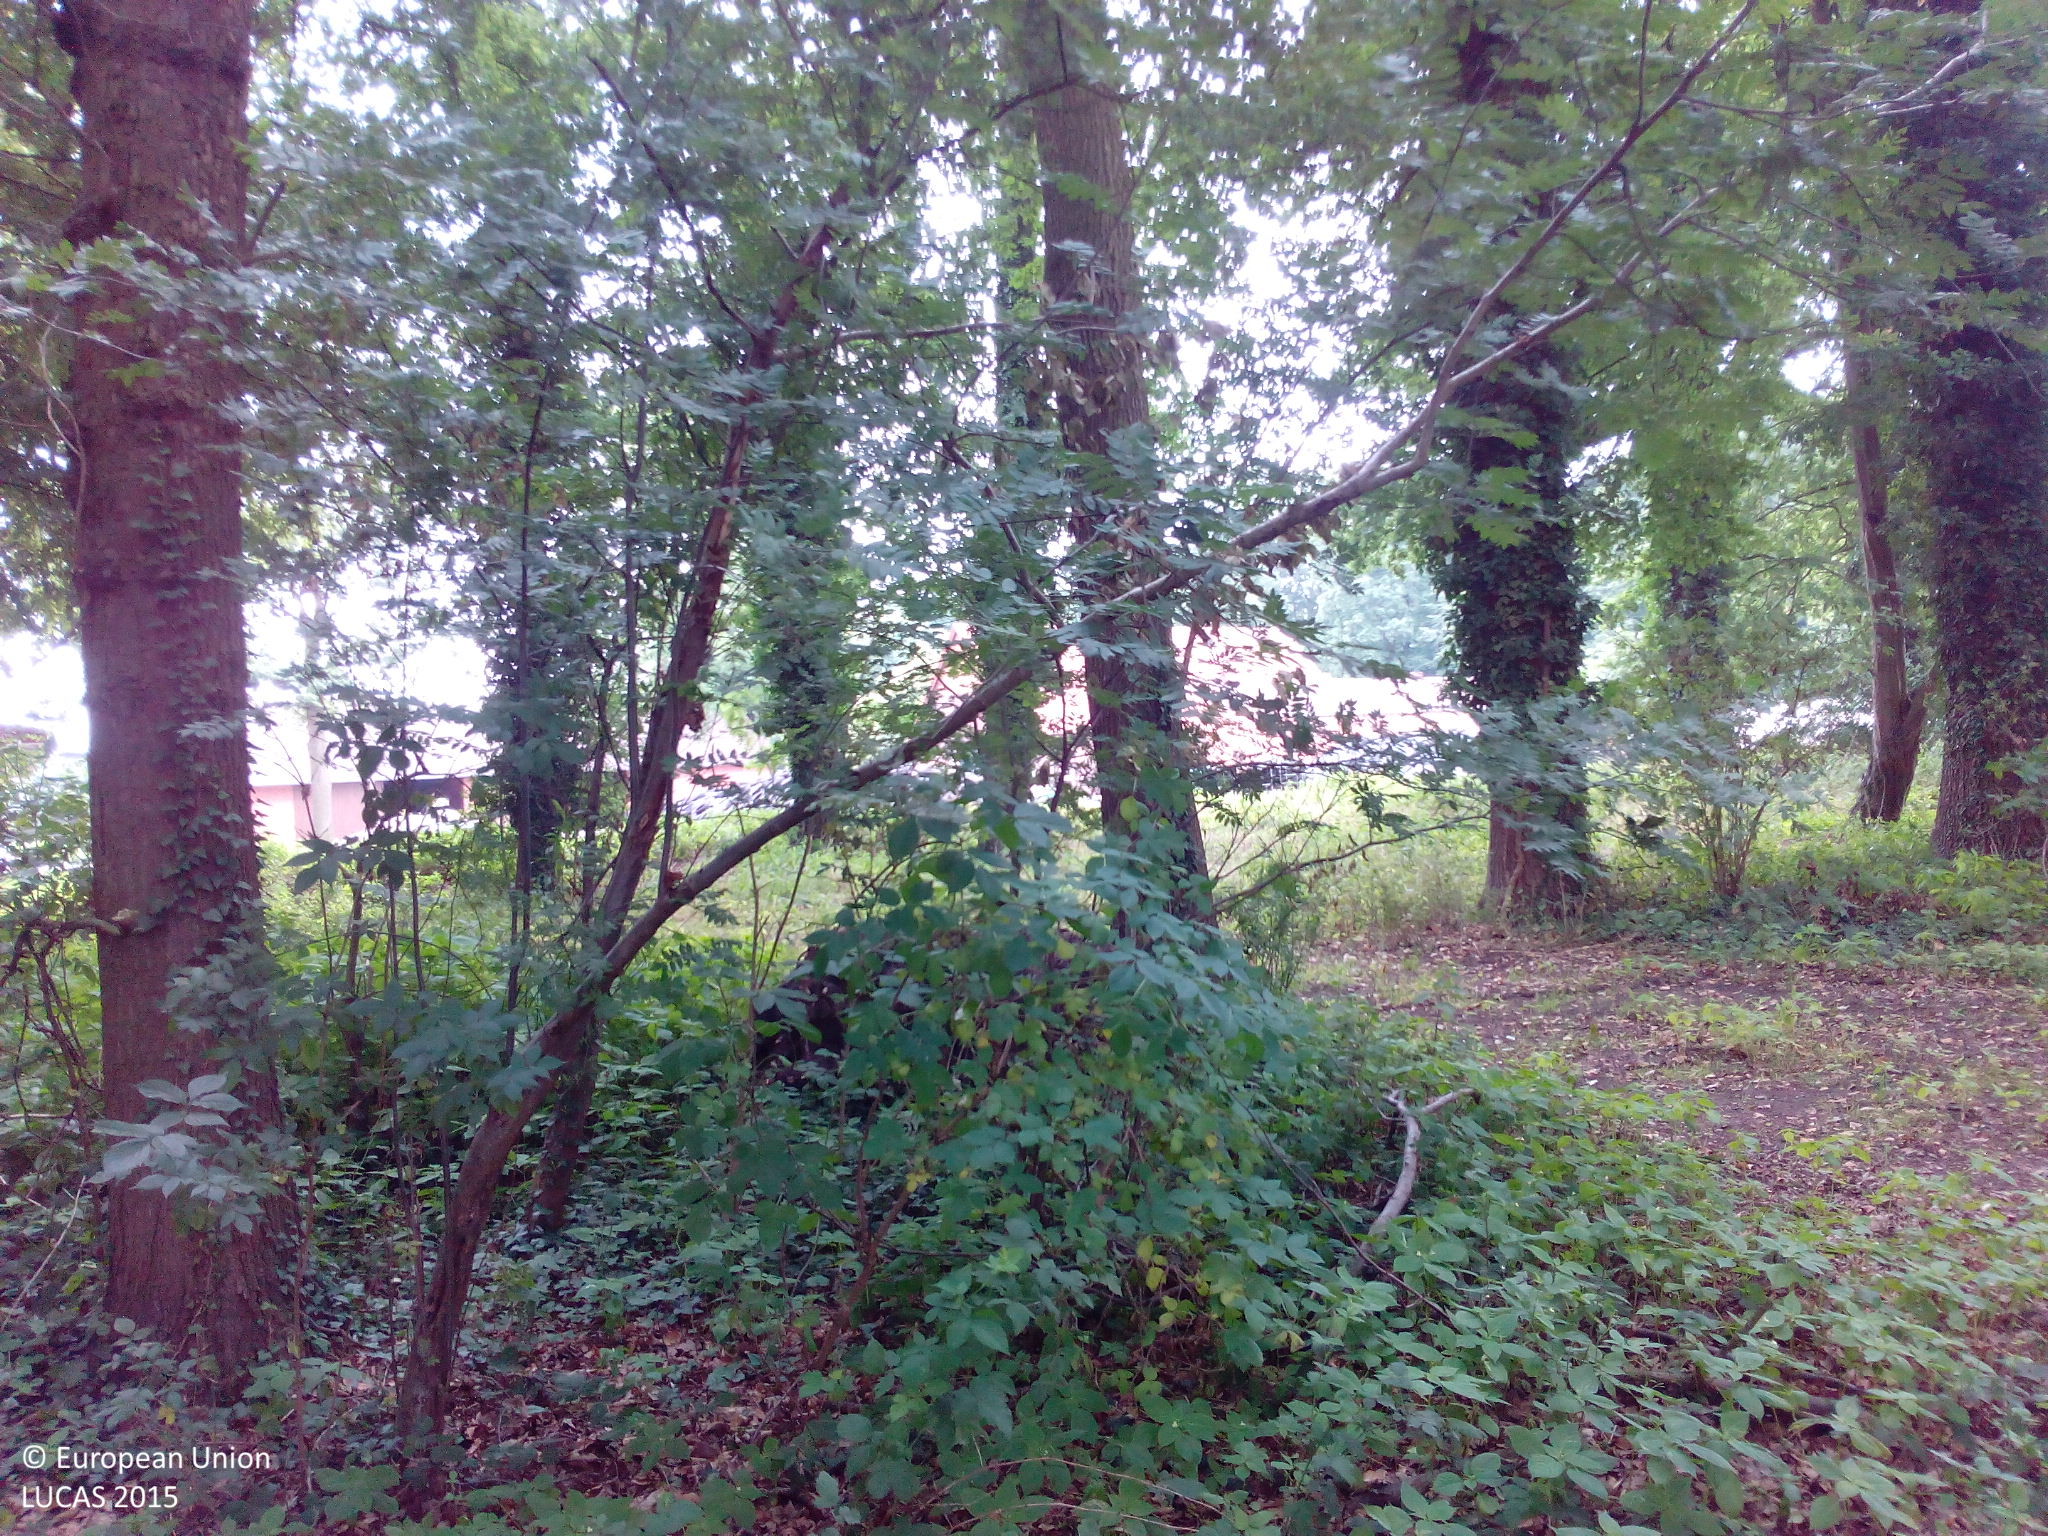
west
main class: Woodland
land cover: Broadleaved woodland
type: mesophytic deciduous forest
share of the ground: > 75 %
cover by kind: broadleaved forest trees 100 %
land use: Agriculture (excluding fallow land and kitchen gardens)
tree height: > 5 m
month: July
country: DE
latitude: 51.8295
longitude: 8.5638
